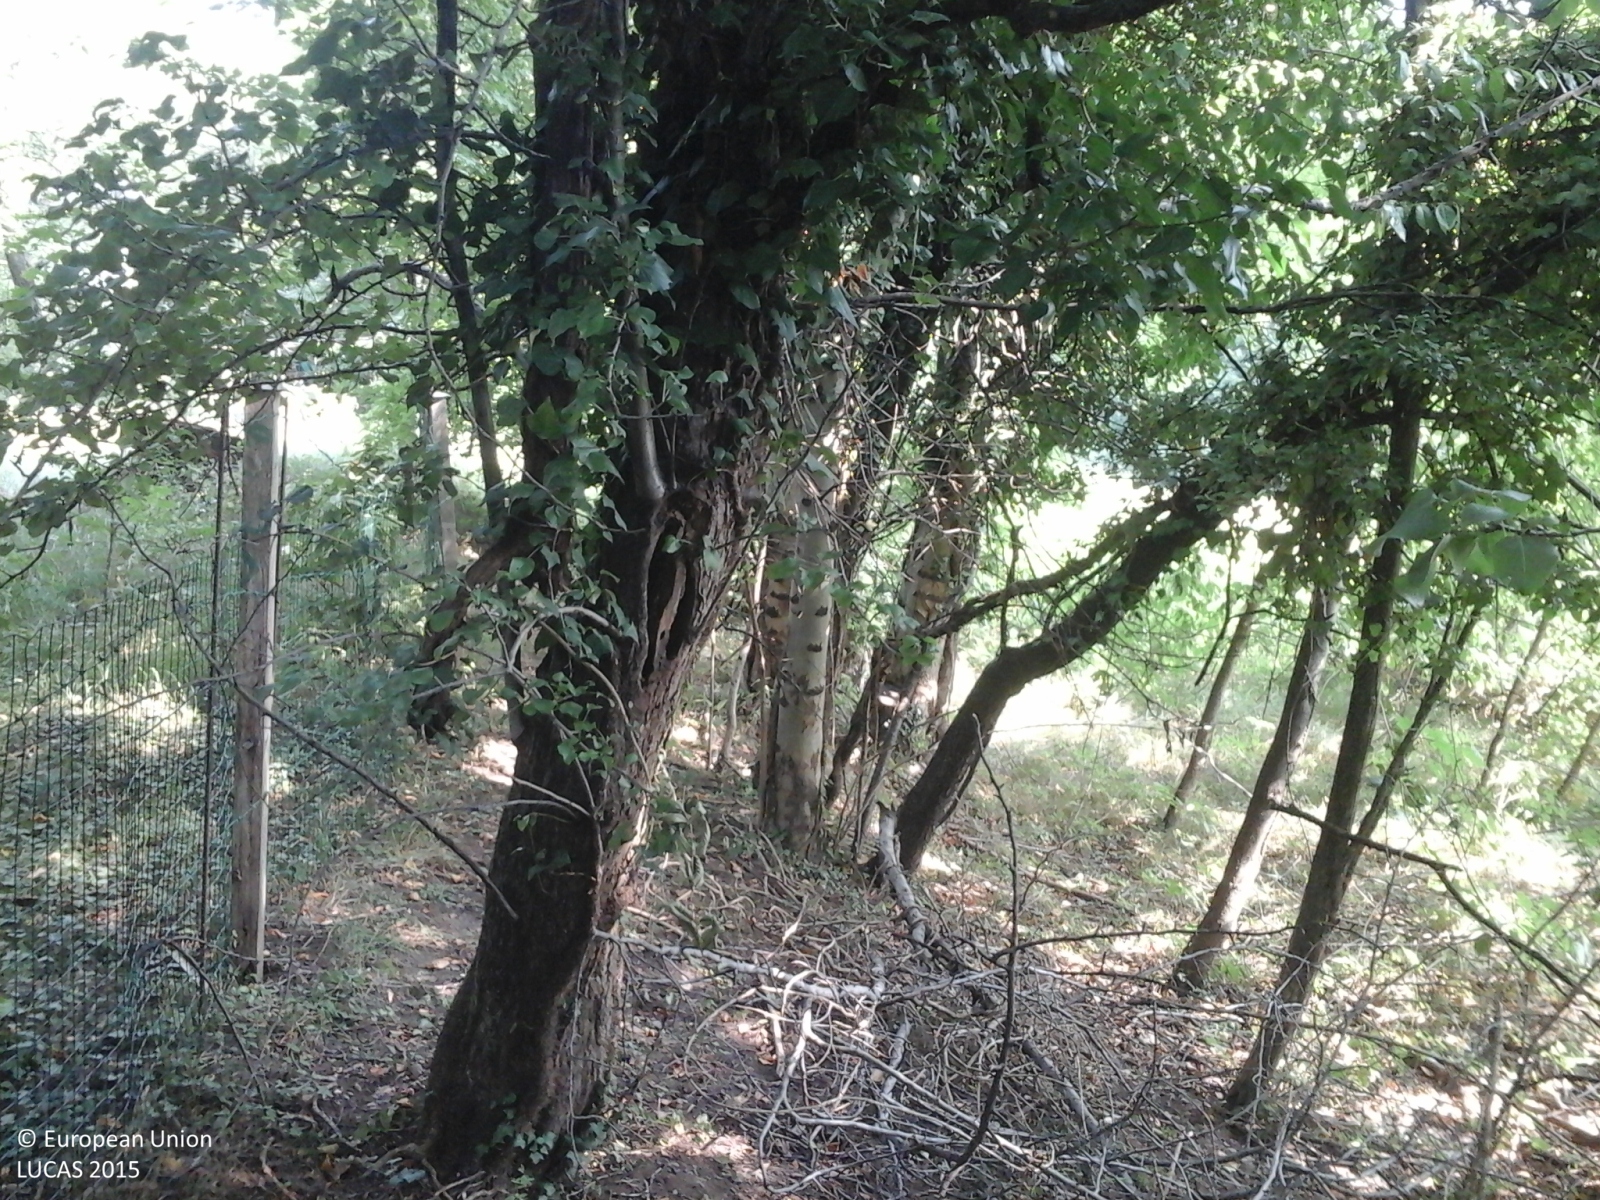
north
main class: Woodland
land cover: Broadleaved woodland
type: thermophilous deciduous forest
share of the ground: > 75 %
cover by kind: broadleaved forest trees 90 %, shrubs 10 %
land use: Forestry
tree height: > 5 m
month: July
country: IT
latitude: 45.9475
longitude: 8.7505
